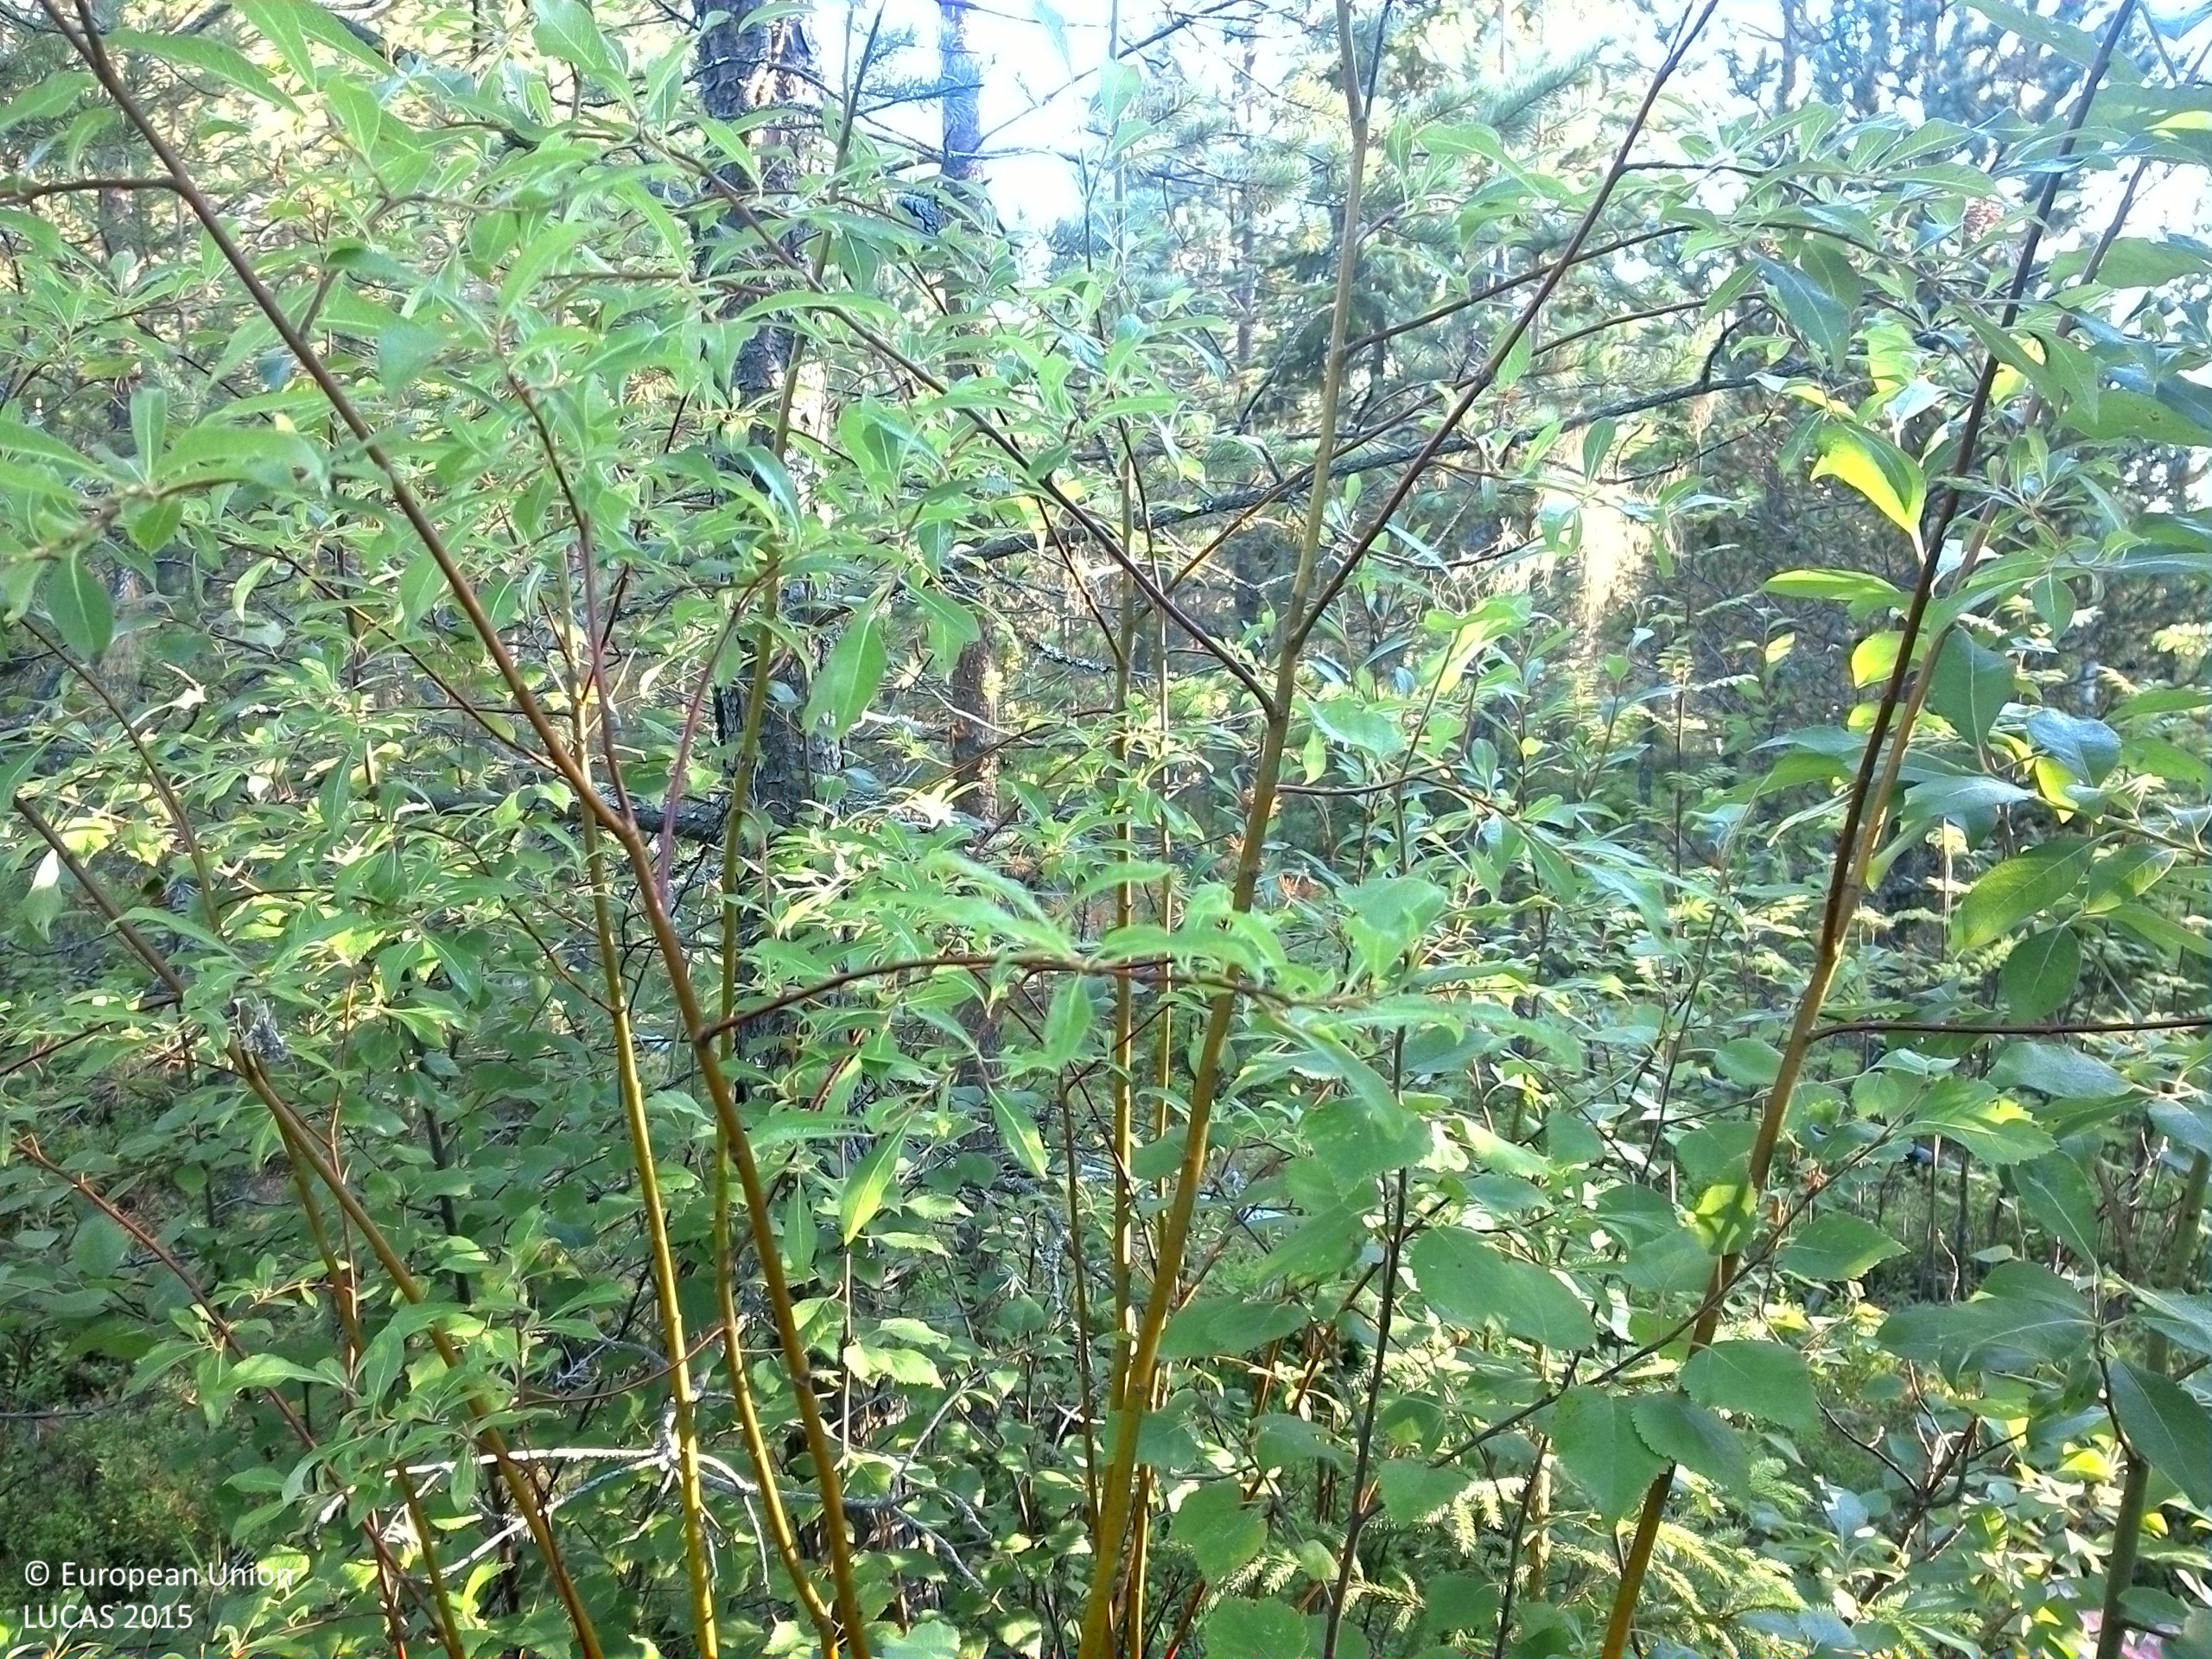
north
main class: Woodland
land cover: Pine dominated coniferous woodland
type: boreal forest
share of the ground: 25 - 50 %
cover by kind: shrubs 40 %, coniferous forest trees 35 %, lichens and mosses 15 %, broadleaved forest trees 5 %, herbaceous plants 5 %
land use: Forestry
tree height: > 5 m
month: August
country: SE
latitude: 64.1141
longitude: 16.6422
